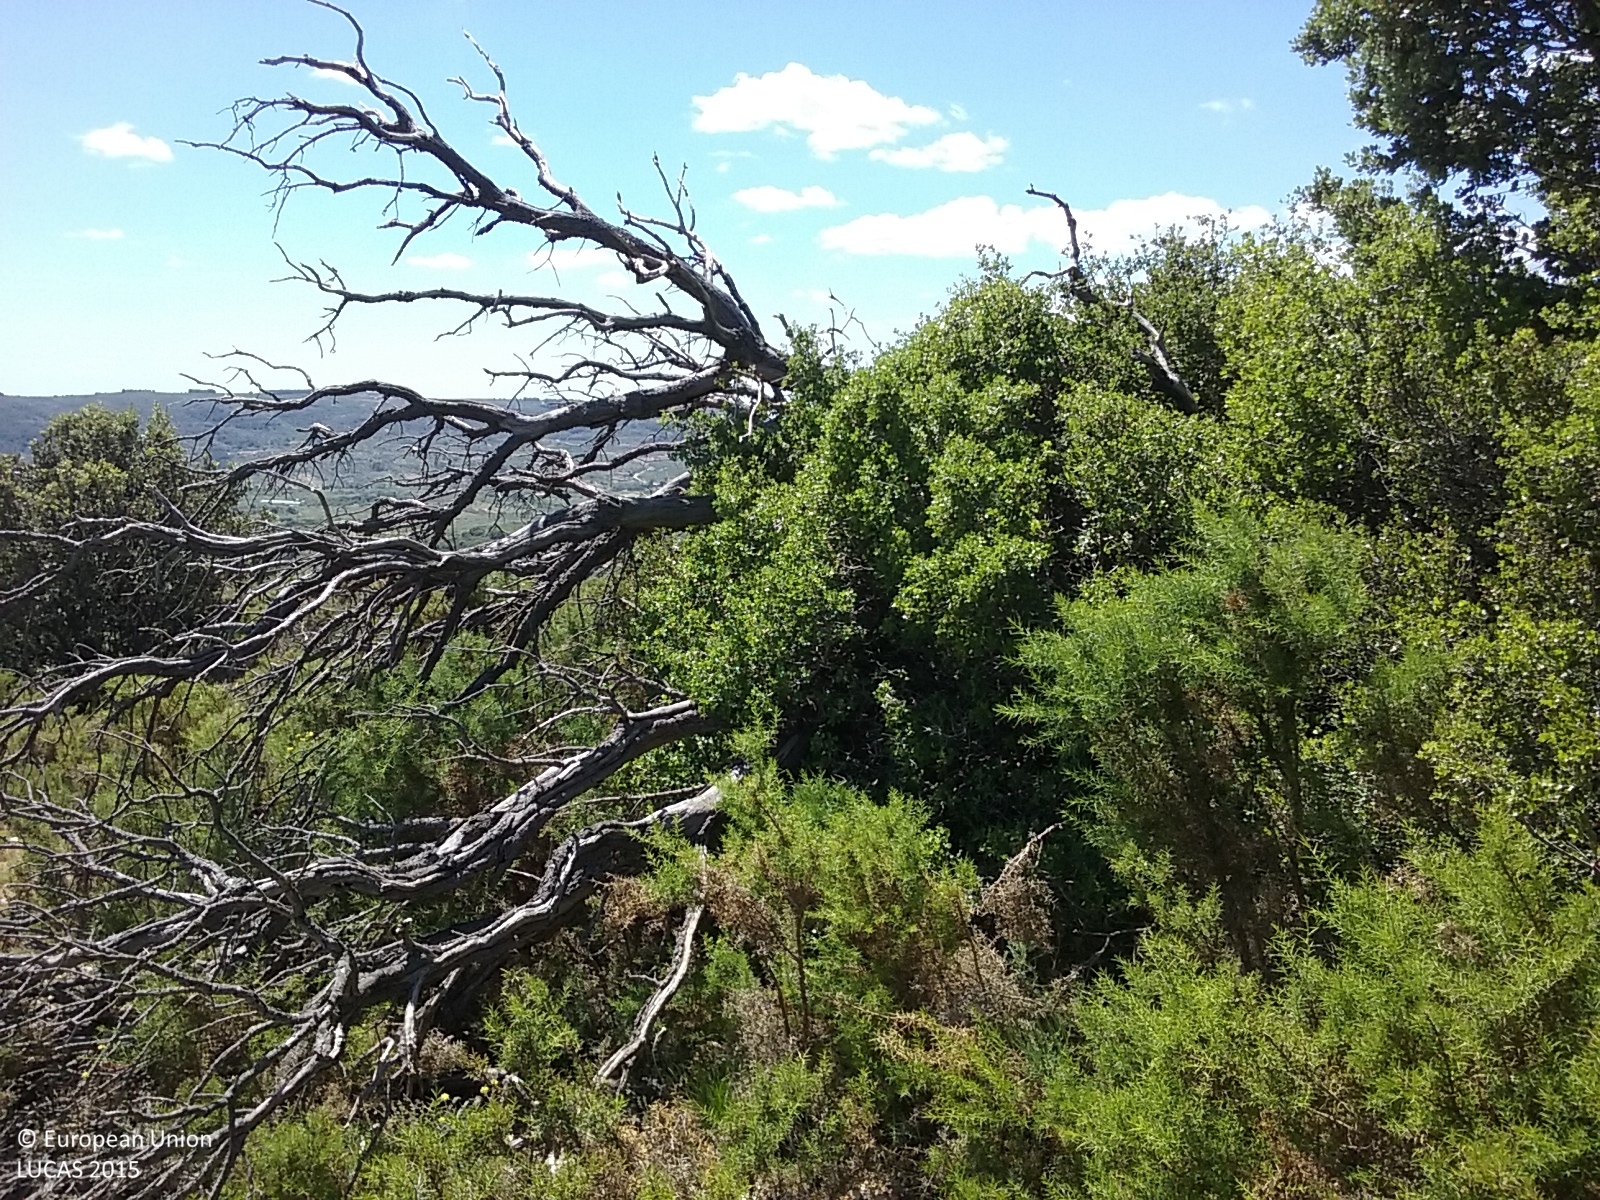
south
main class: Shrubland
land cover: Shrubland with sparse tree cover
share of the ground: > 75 %
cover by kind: shrubs 95 %, broadleaved forest trees 5 %
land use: Semi-natural and natural areas not in use
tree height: < 5 m
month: May
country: ES
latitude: 40.4553
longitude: 0.0781
